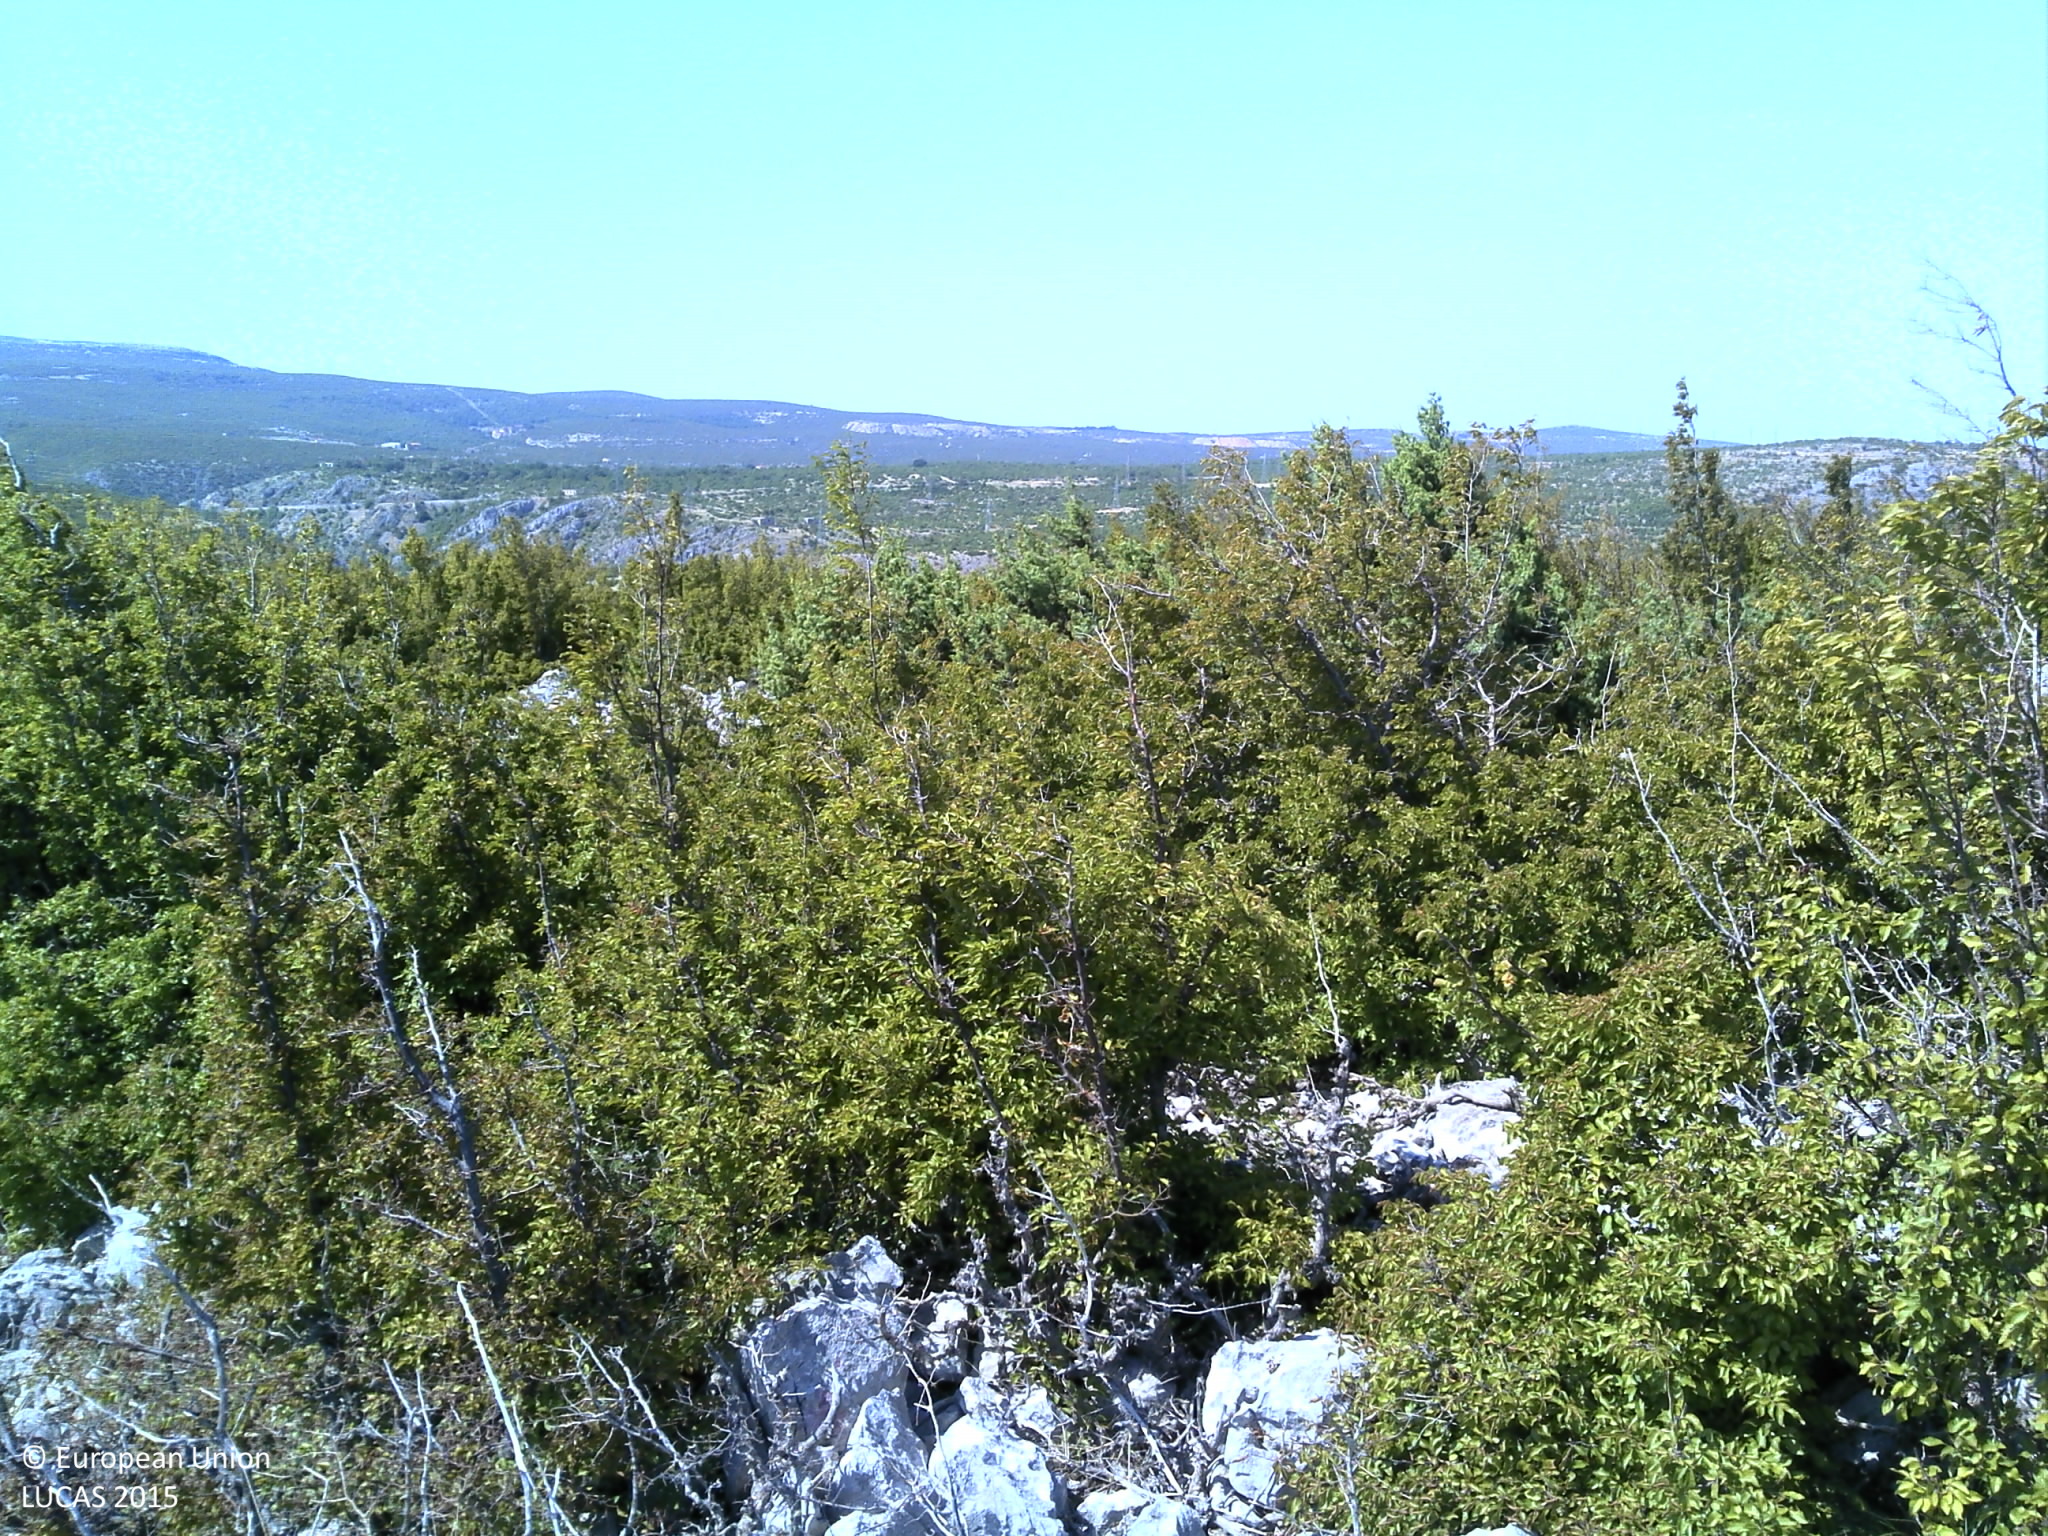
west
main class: Shrubland
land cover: Shrubland with sparse tree cover
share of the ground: > 75 %
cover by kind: shrubs 50 %, unconsolidated bare surface 25 %, herbaceous plants 20 %, broadleaved forest trees 5 %
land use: Semi-natural and natural areas not in use
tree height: < 5 m
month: August
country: HR
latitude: 44.2113
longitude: 15.7121
